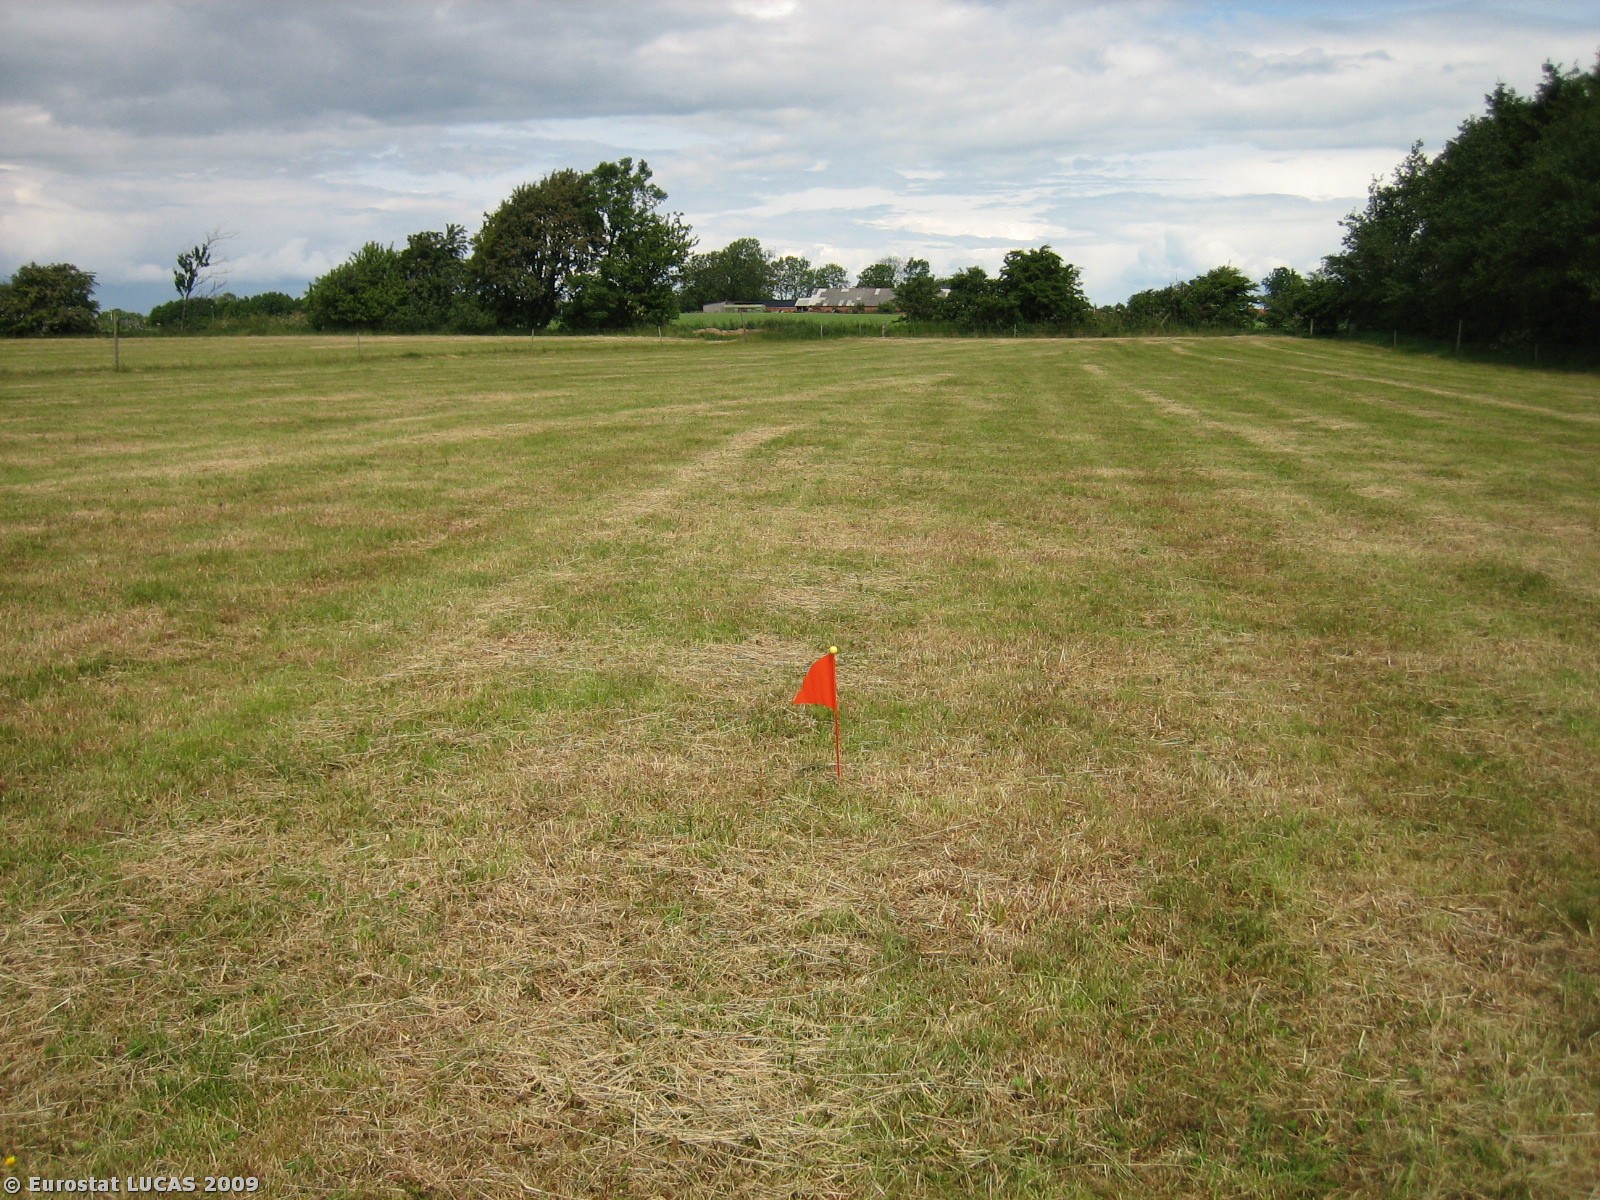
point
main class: Grassland
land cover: Grassland without tree/shrub cover
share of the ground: > 75 %
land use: Agriculture (excluding fallow land and kitchen gardens)
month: June
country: DK
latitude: 56.2593
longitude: 9.7259
